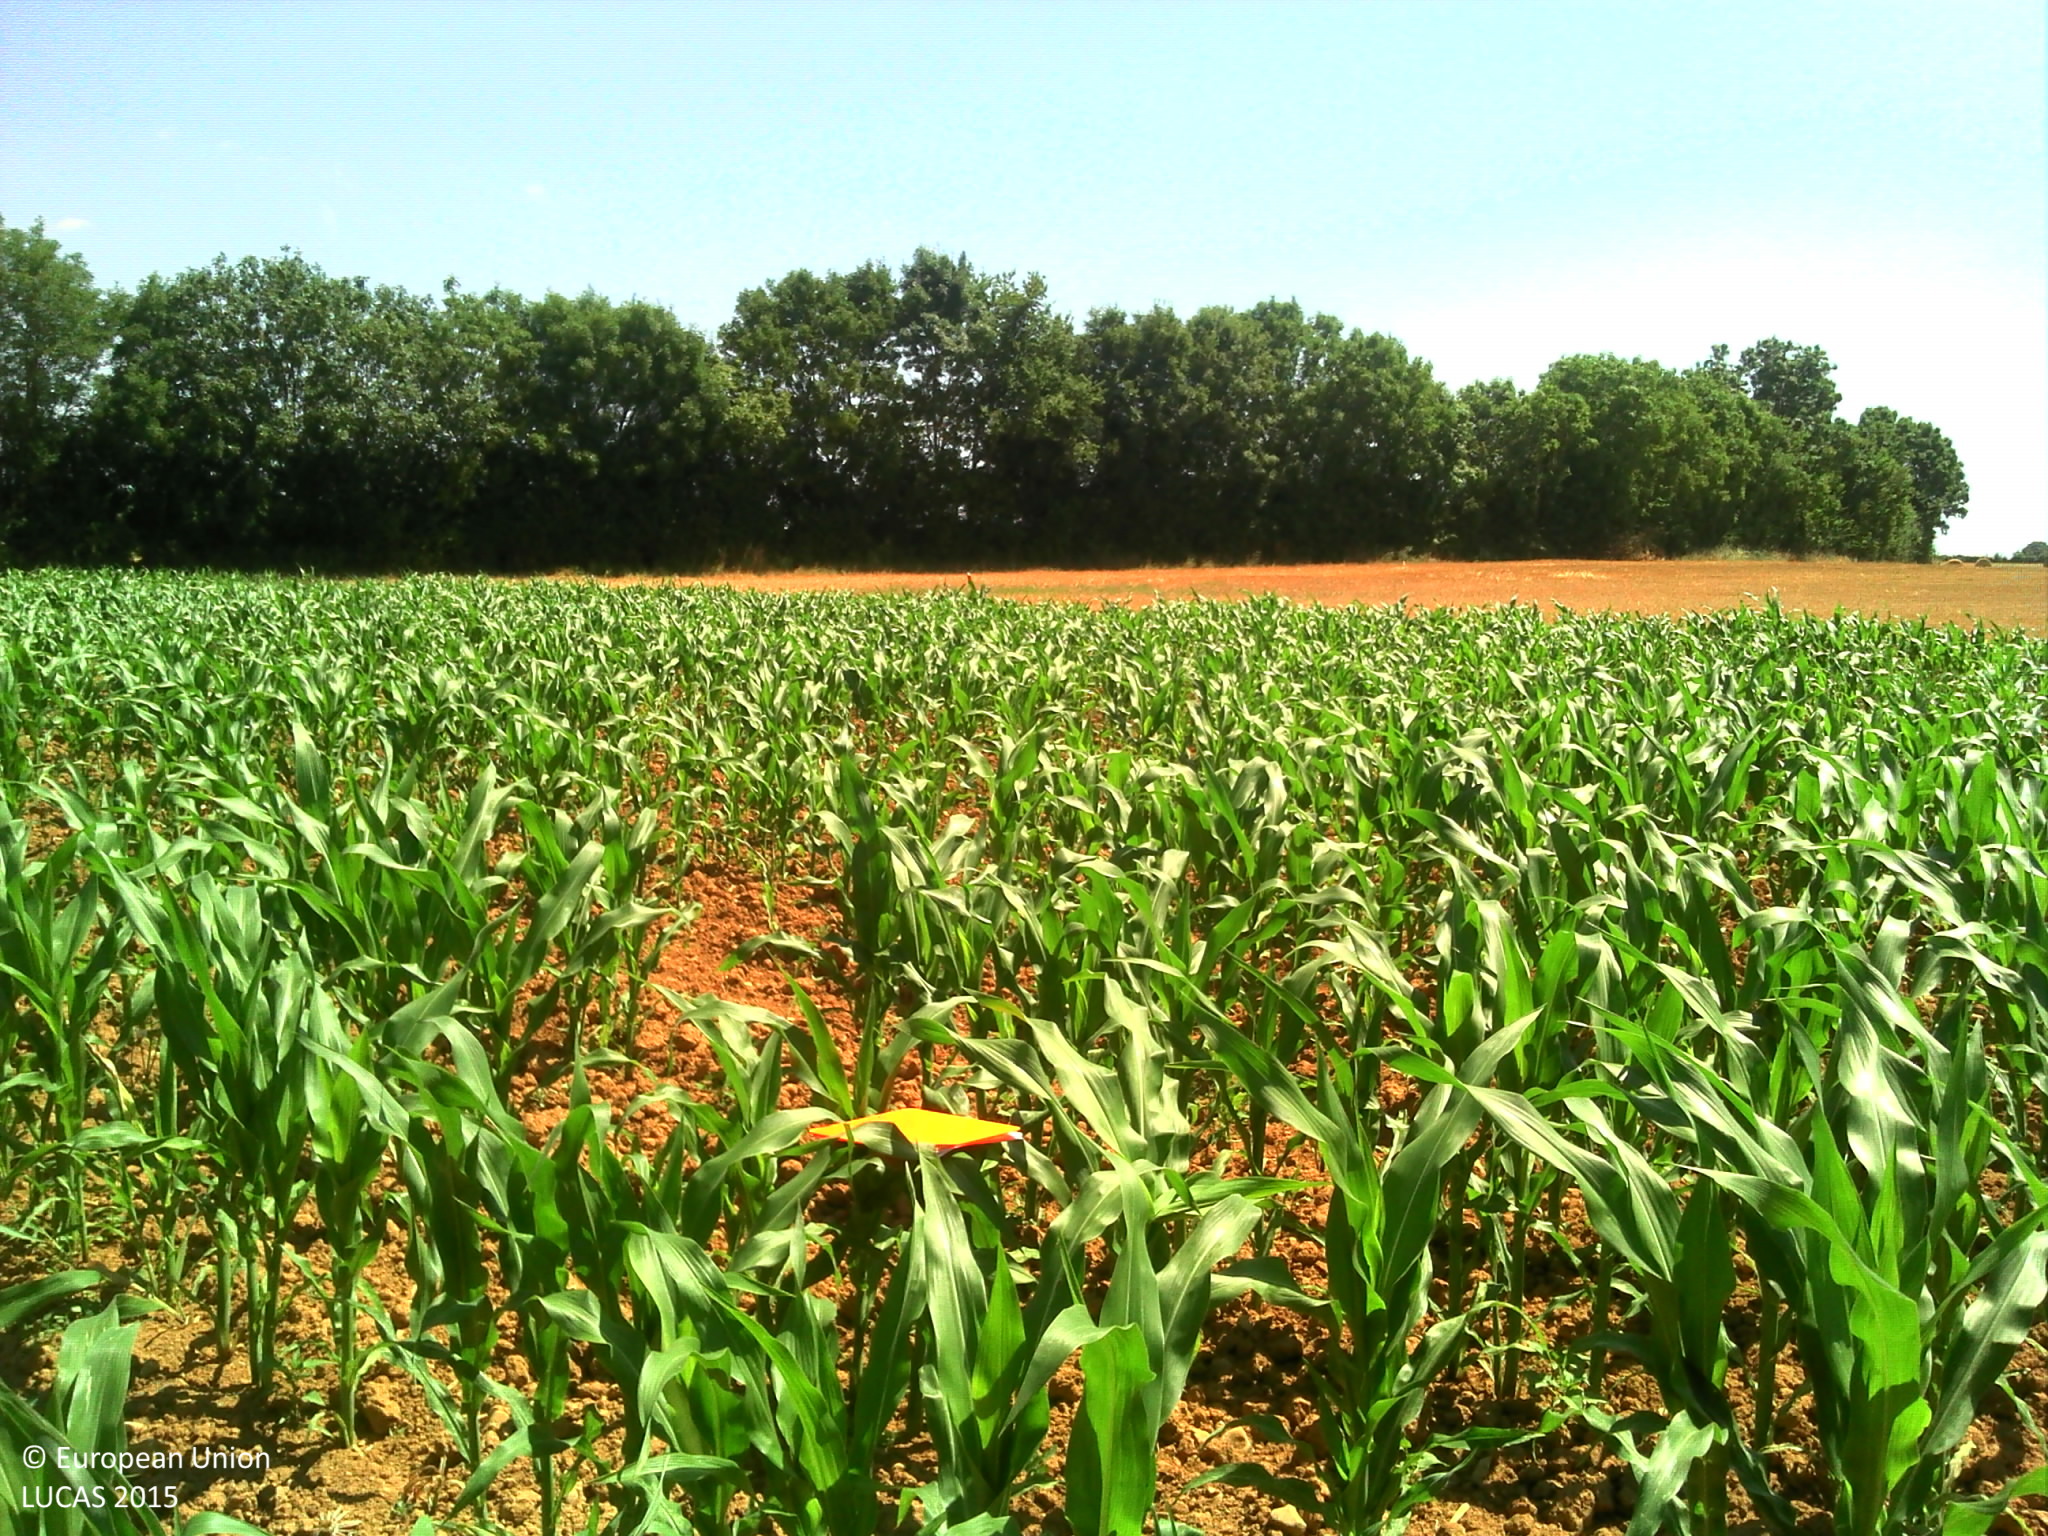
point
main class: Cropland
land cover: Maize
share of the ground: > 75 %
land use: Agriculture (excluding fallow land and kitchen gardens)
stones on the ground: < 10 %
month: July
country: FR
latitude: 46.4718
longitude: -1.3533
